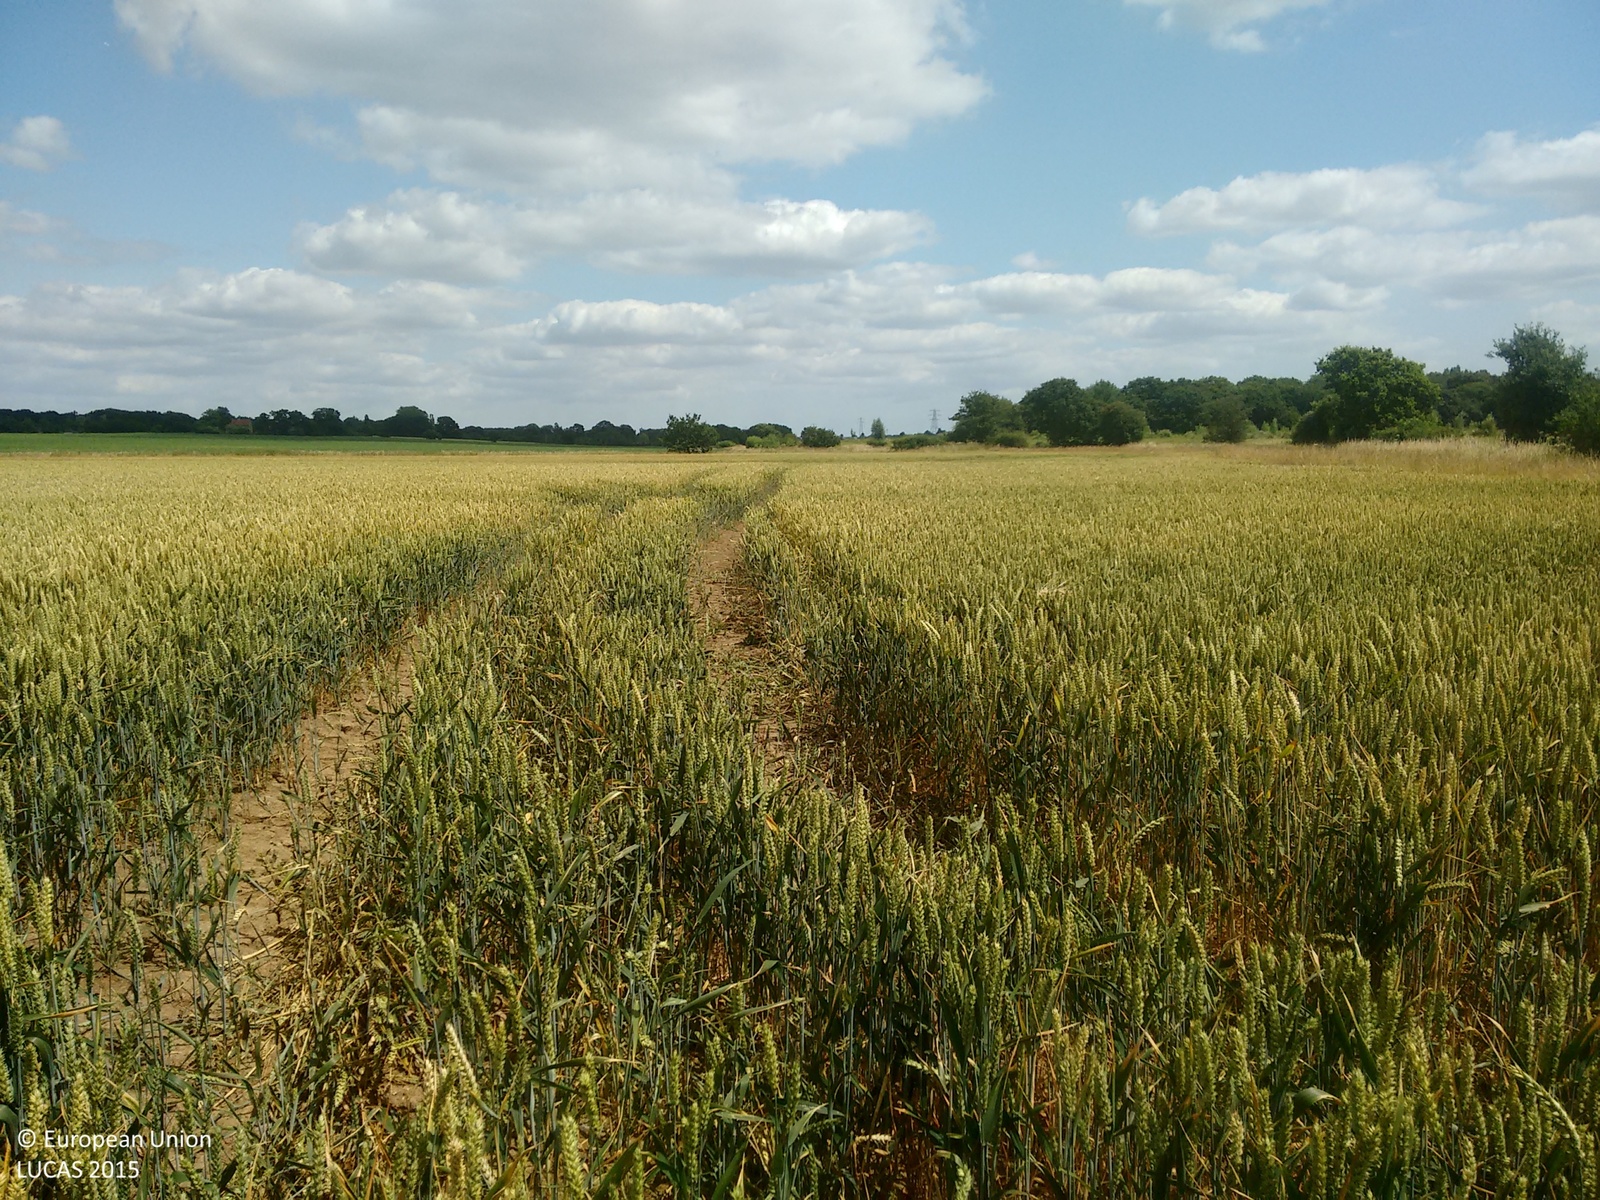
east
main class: Shrubland
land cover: Shrubland with sparse tree cover
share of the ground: > 75 %
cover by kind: shrubs 95 %, broadleaved forest trees 5 %
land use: Semi-natural and natural areas not in use
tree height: < 5 m
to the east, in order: Shrubland with sparse tree cover; Ditches and canals; Managed hedges; Grassland without tree/shrub cover; Common wheat; Grassland without tree/shrub cover; Tracks; Ditches and canals; Single bushes/trees; Grassland without tree/shrub cover; Inland fresh water bodies
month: July
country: GB
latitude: 51.5894
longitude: 0.4016
